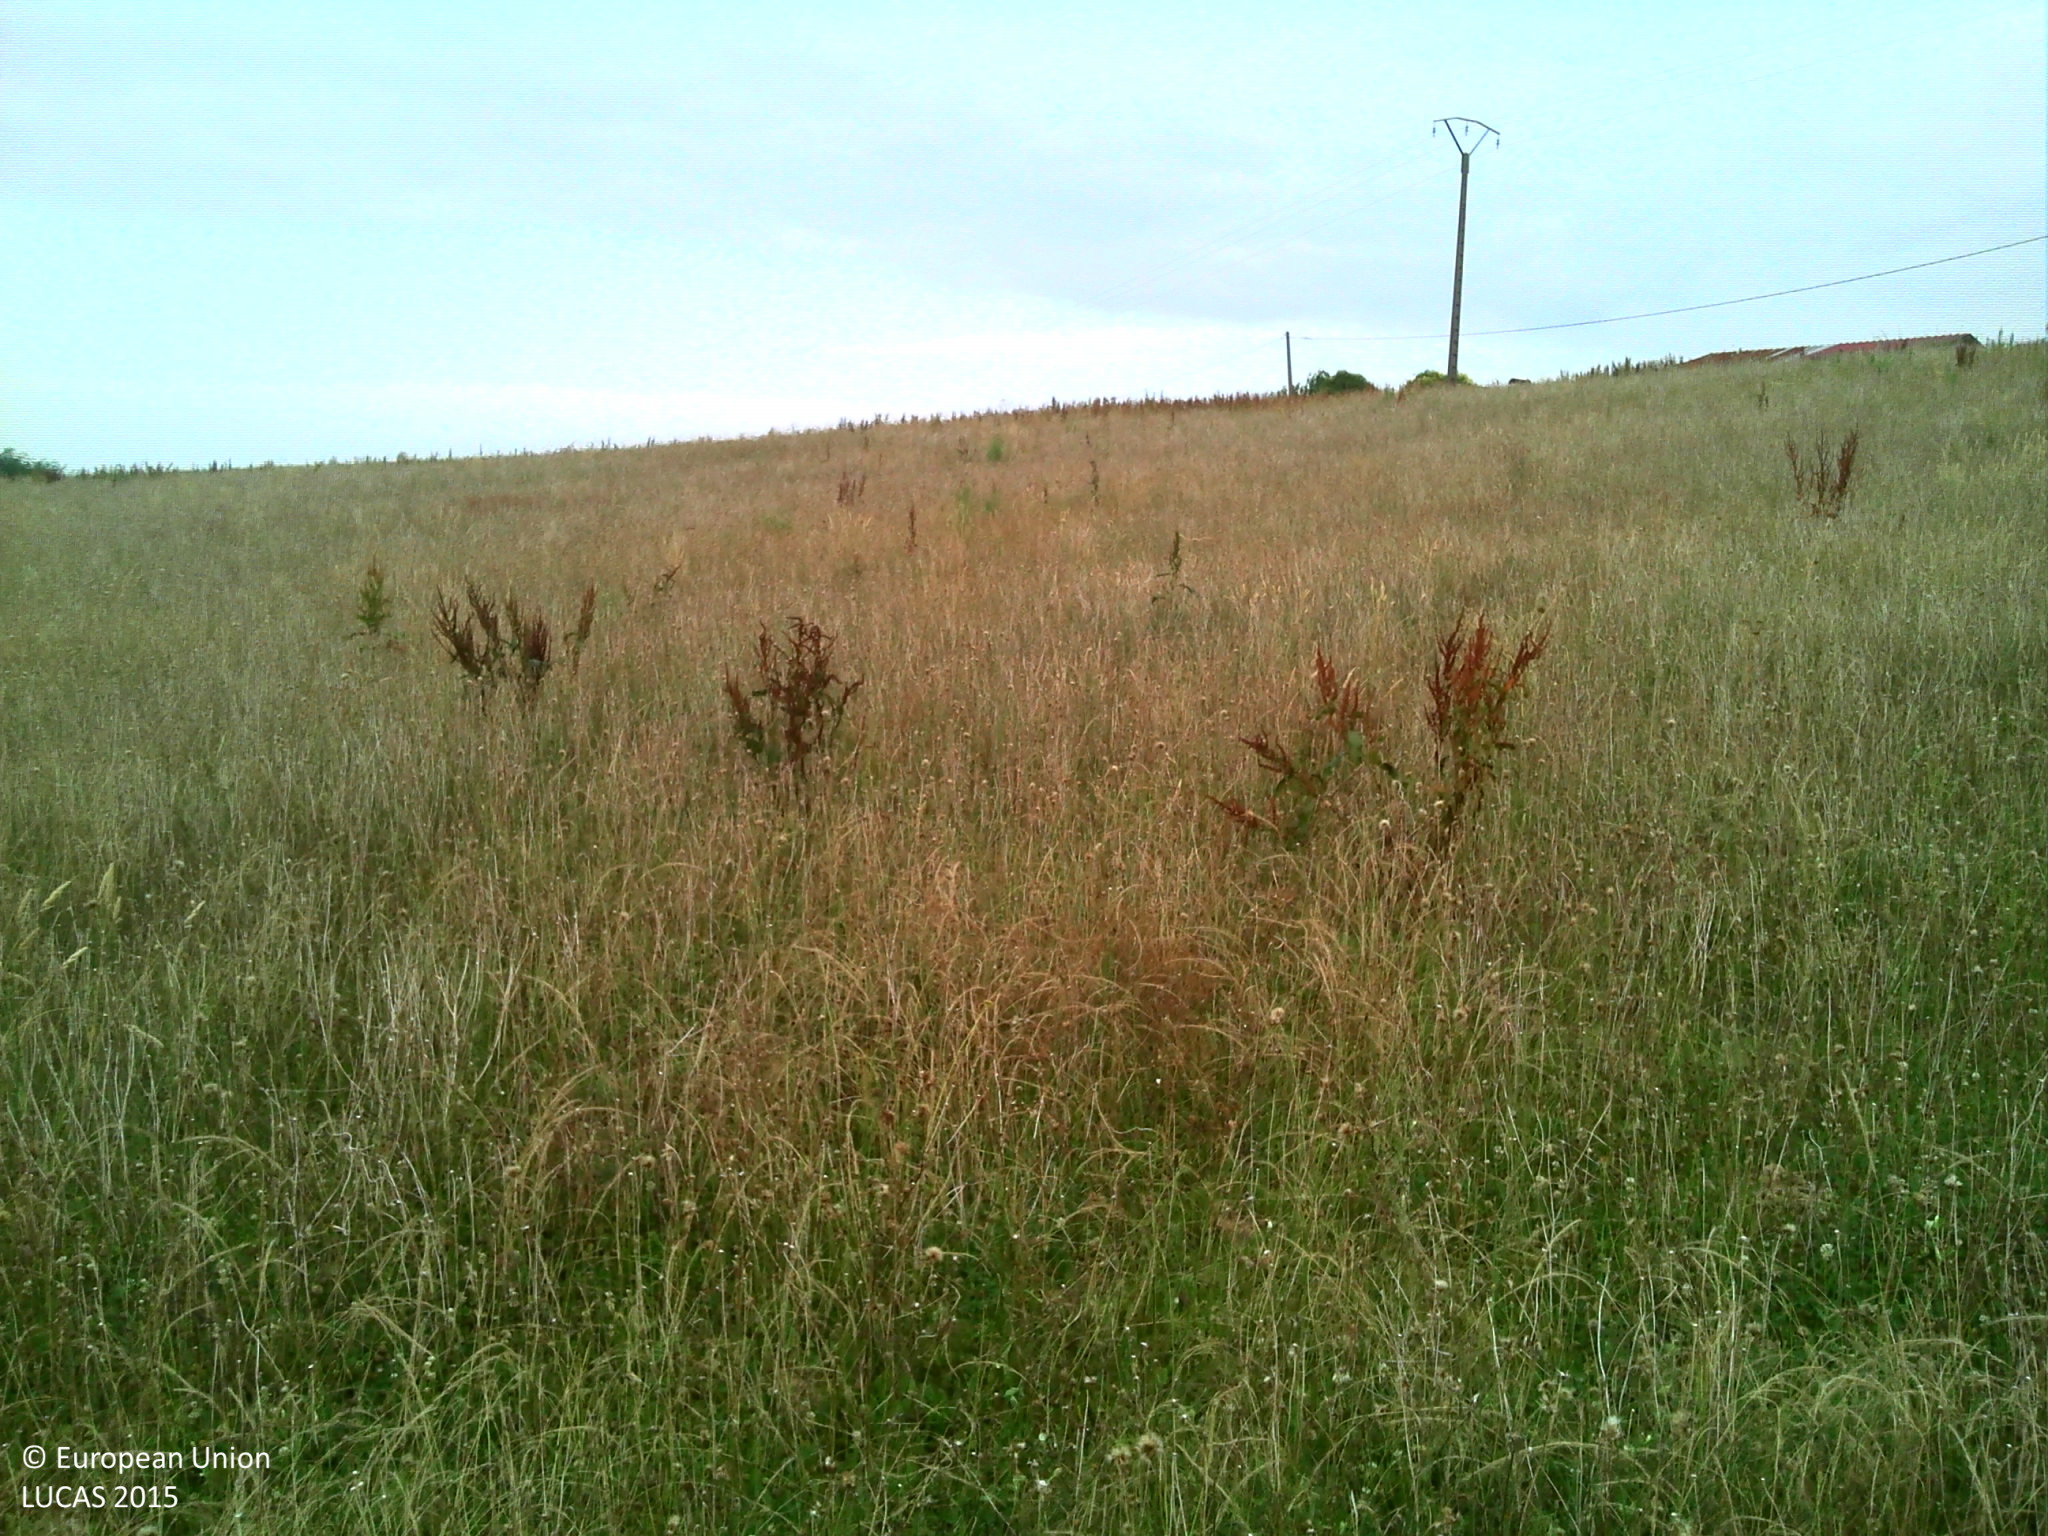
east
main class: Grassland
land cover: Grassland without tree/shrub cover
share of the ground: > 75 %
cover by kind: herbaceous plants 100 %
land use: Agriculture (excluding fallow land and kitchen gardens)
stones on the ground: < 10 %
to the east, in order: Grassland without tree/shrub cover; Shruby margins; Ditches and canals; Sunflower; Tracks; Grass margins; Ditches and canals; Electric lines; Grass margins; Paved roads, cycling and walking lanes; Grass margins; Ditches and canals; Electric lines; Tracks
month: July
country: FR
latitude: 43.6796
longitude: -0.7673
